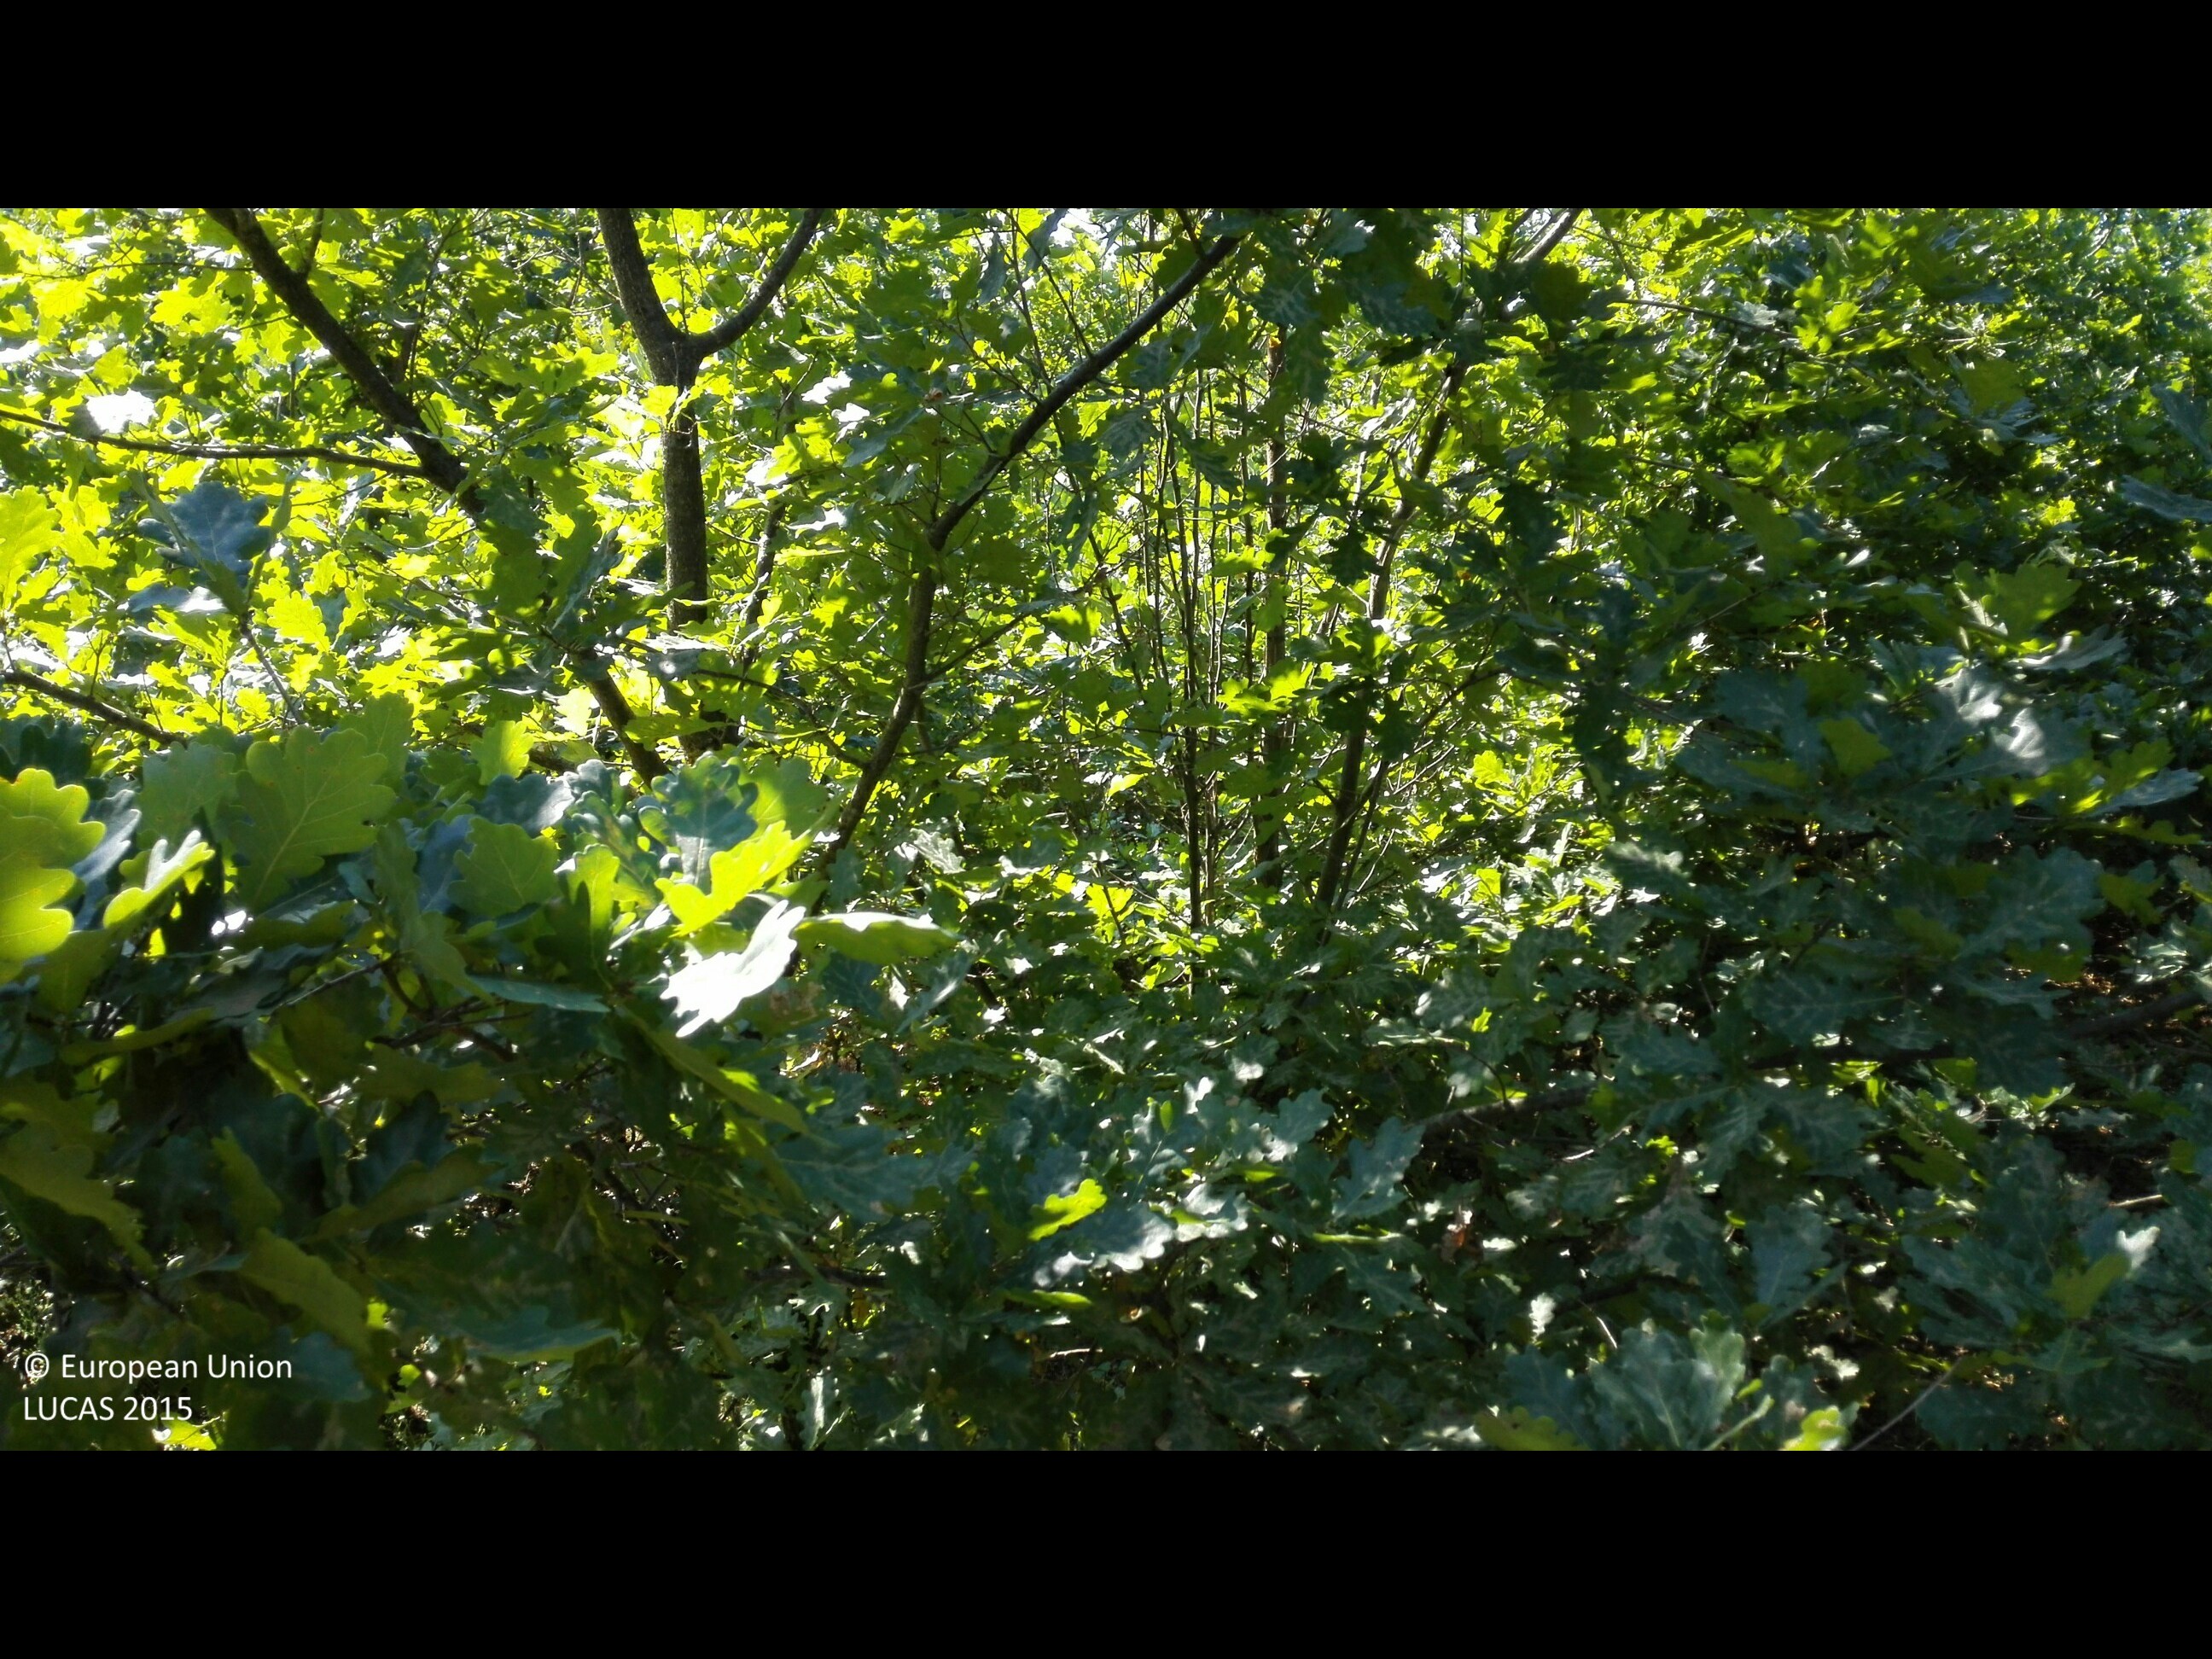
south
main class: Woodland
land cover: Broadleaved woodland
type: acidophilous oak and oak-birch forest
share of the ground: > 75 %
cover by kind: broadleaved forest trees 95 %, herbaceous plants 5 %
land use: Forestry
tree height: < 5 m
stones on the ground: < 10 %
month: August
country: HU
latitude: 47.4615
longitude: 21.7864
